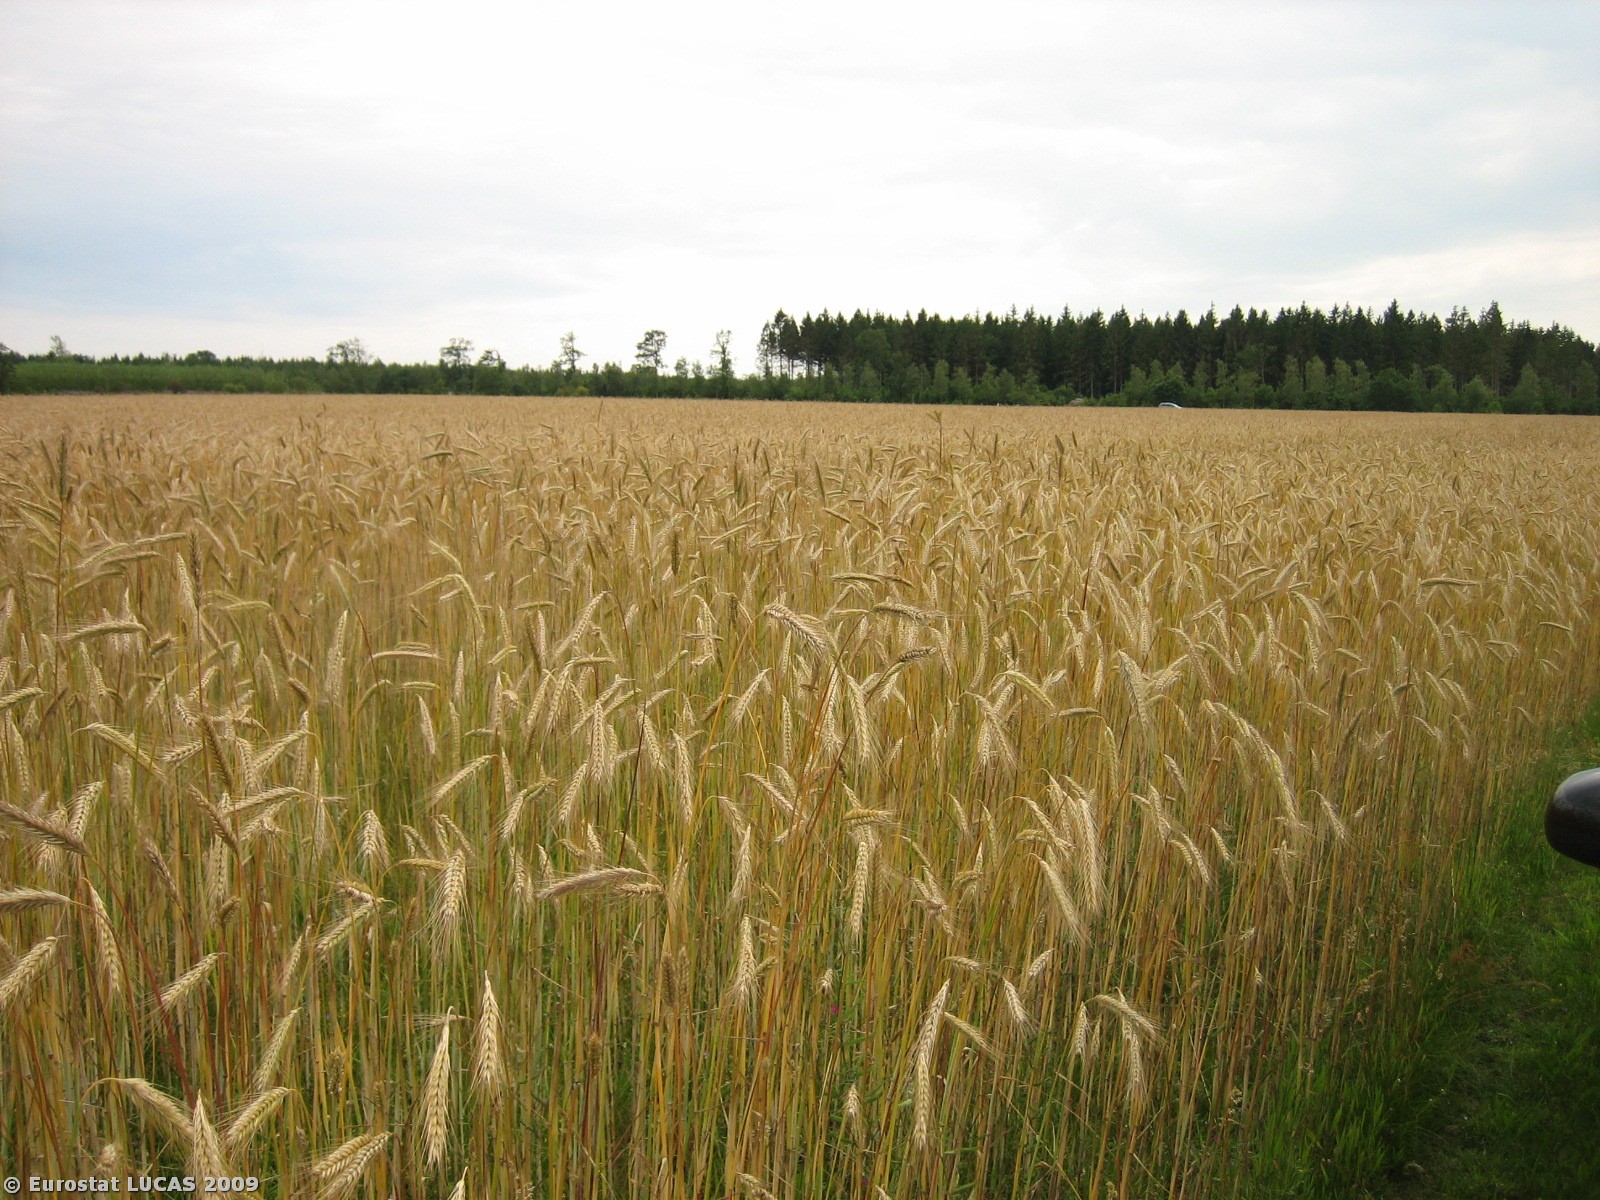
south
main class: Cropland
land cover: Rye
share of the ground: > 75 %
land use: Agriculture (excluding fallow land and kitchen gardens)
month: July
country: DK
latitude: 55.8580
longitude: 8.7392
